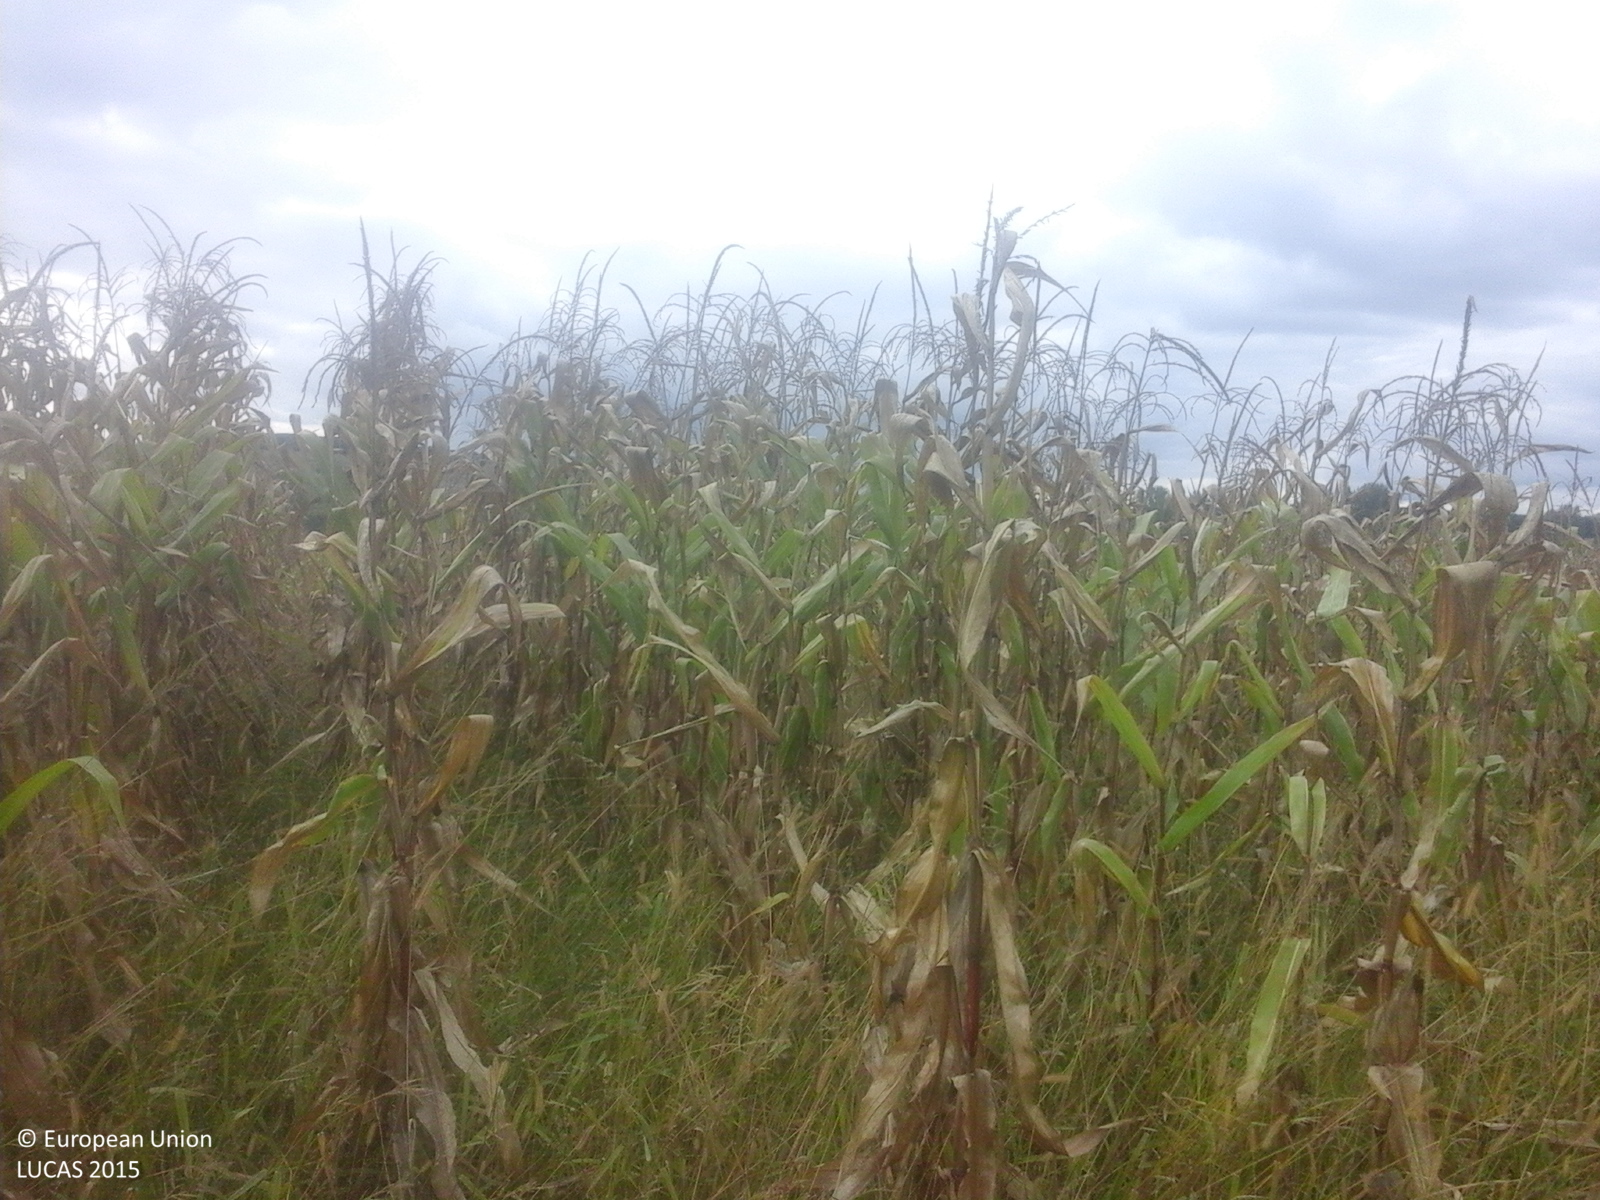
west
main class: Cropland
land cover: Maize
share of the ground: > 75 %
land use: Agriculture (excluding fallow land and kitchen gardens)
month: September
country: RO
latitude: 45.8597
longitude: 23.8906
